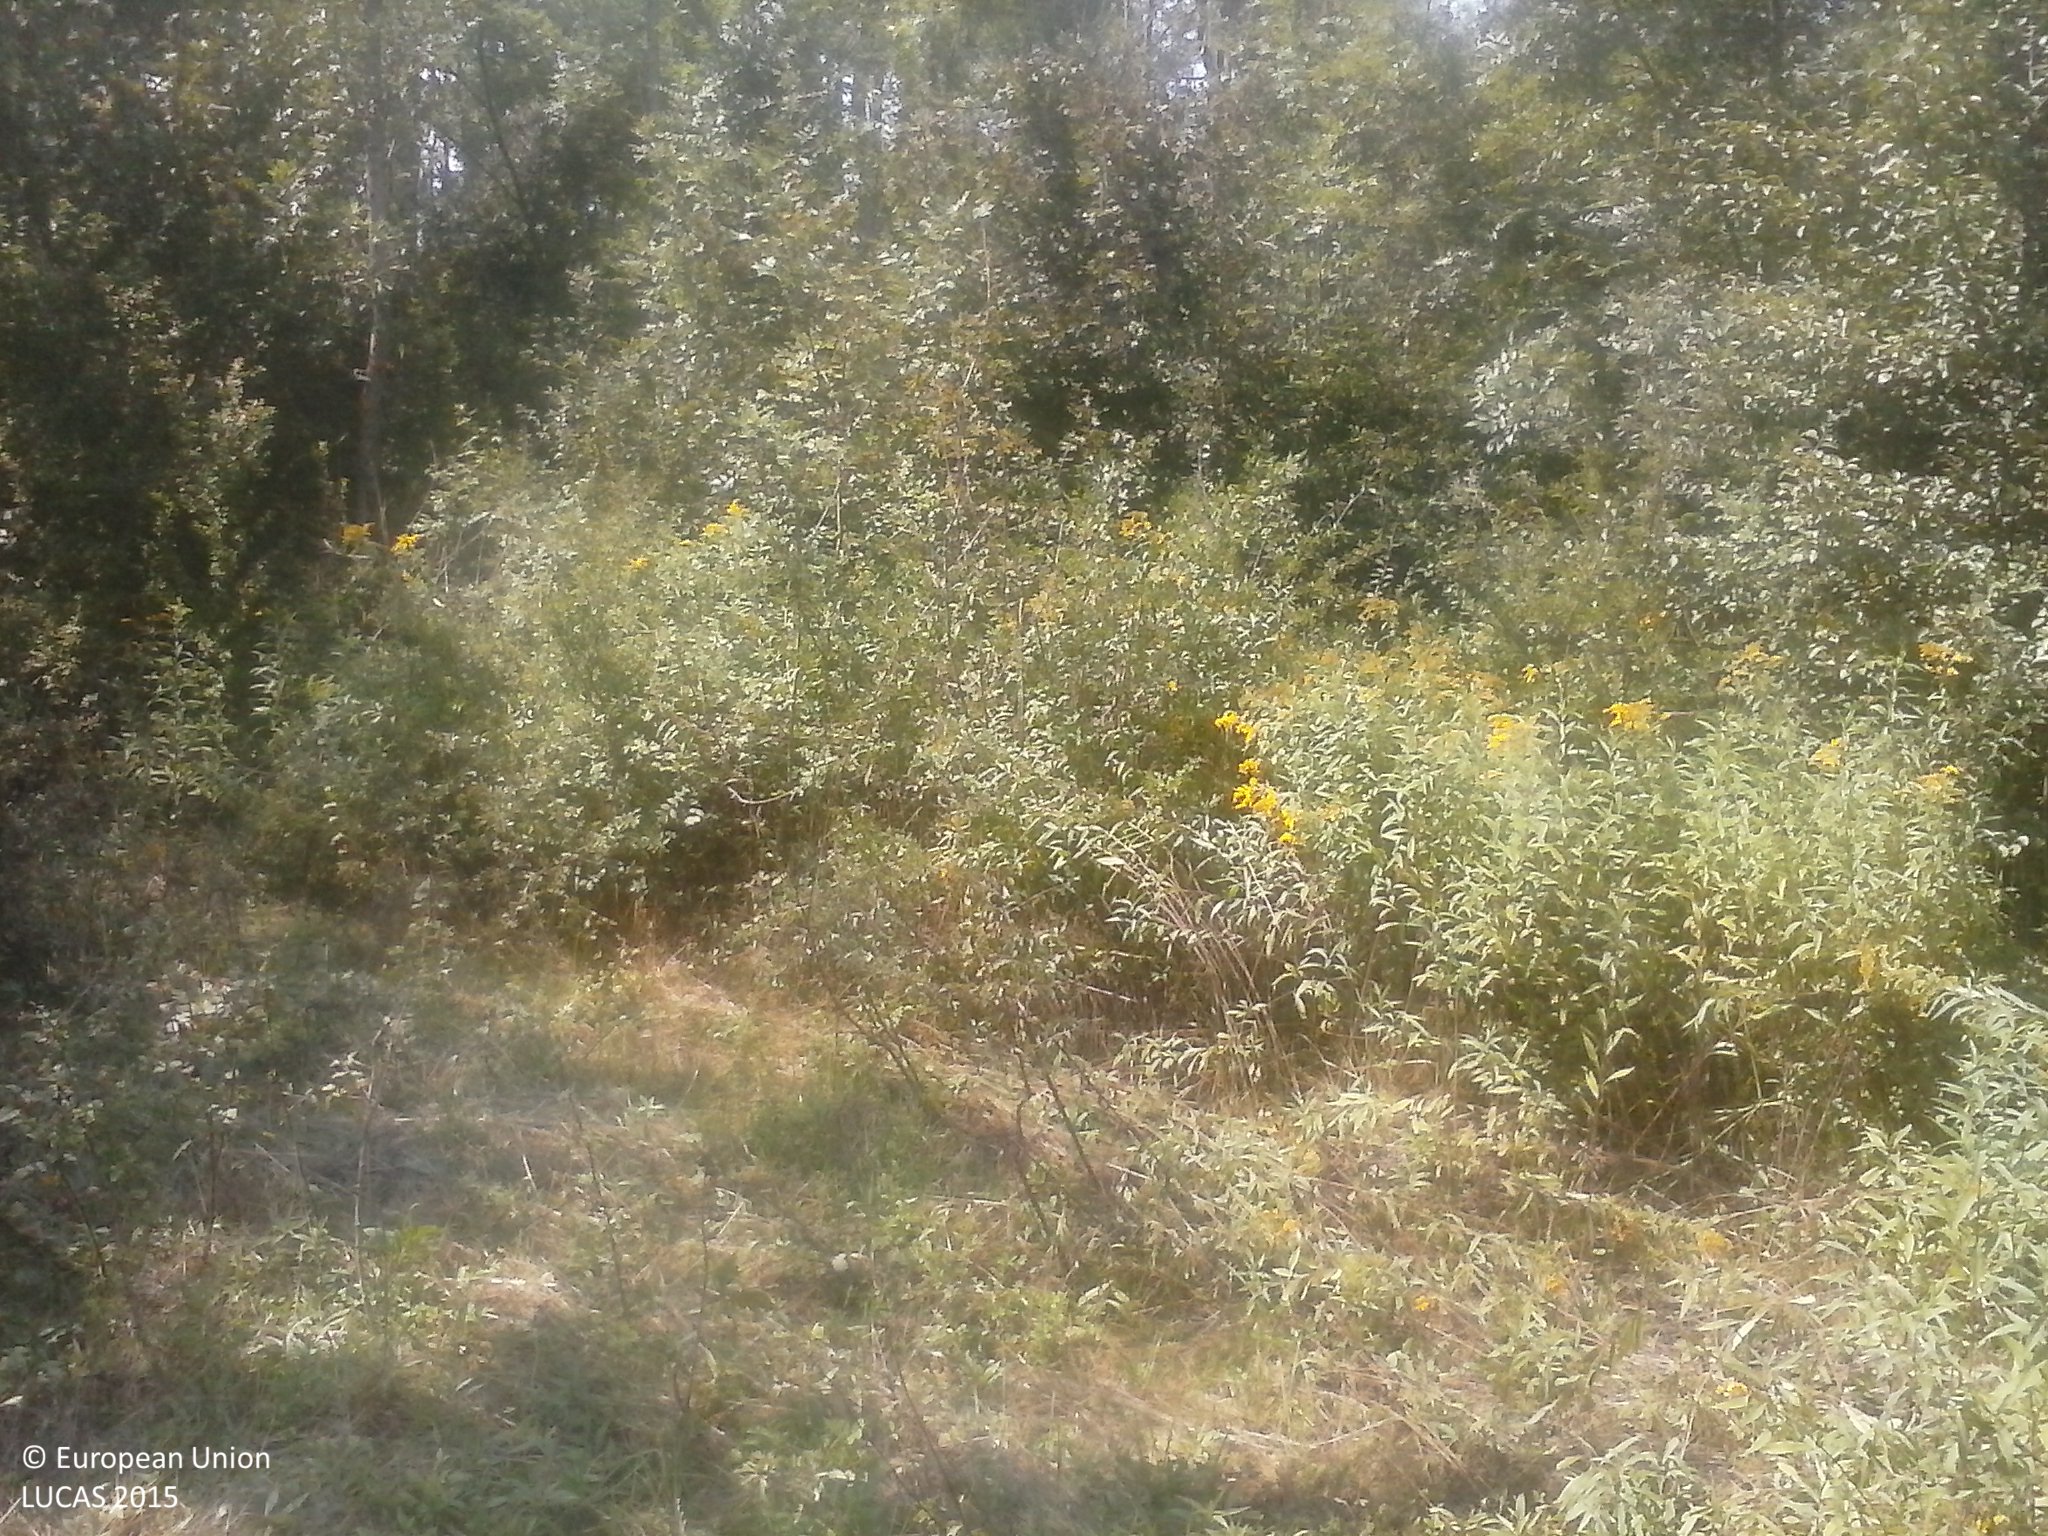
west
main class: Cropland
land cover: Maize
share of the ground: > 75 %
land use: Agriculture (excluding fallow land and kitchen gardens)
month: August
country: HU
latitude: 45.9247
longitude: 17.7540
